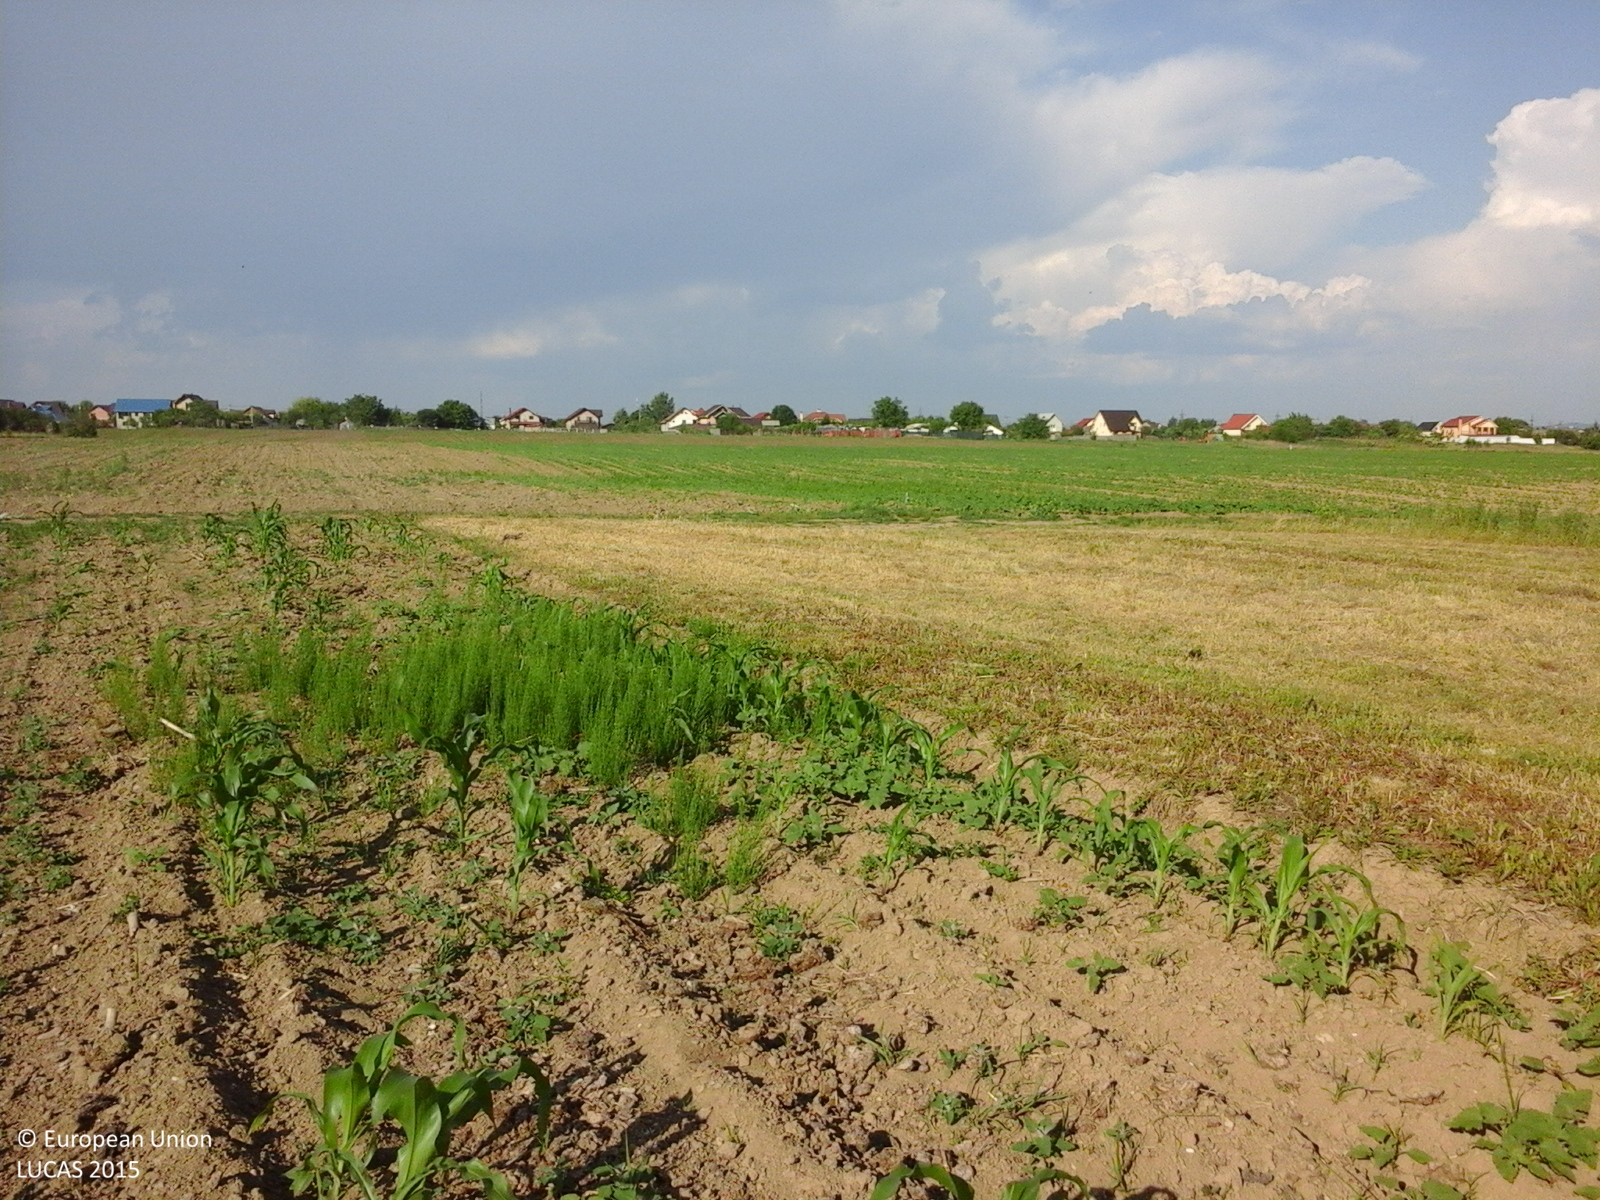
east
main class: Cropland
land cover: Maize
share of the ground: 10 - 25 %
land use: Agriculture (excluding fallow land and kitchen gardens)
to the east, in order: Maize; Grassland without tree/shrub cover; Tracks; Sunflower
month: June
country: RO
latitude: 46.6162
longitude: 26.8728
